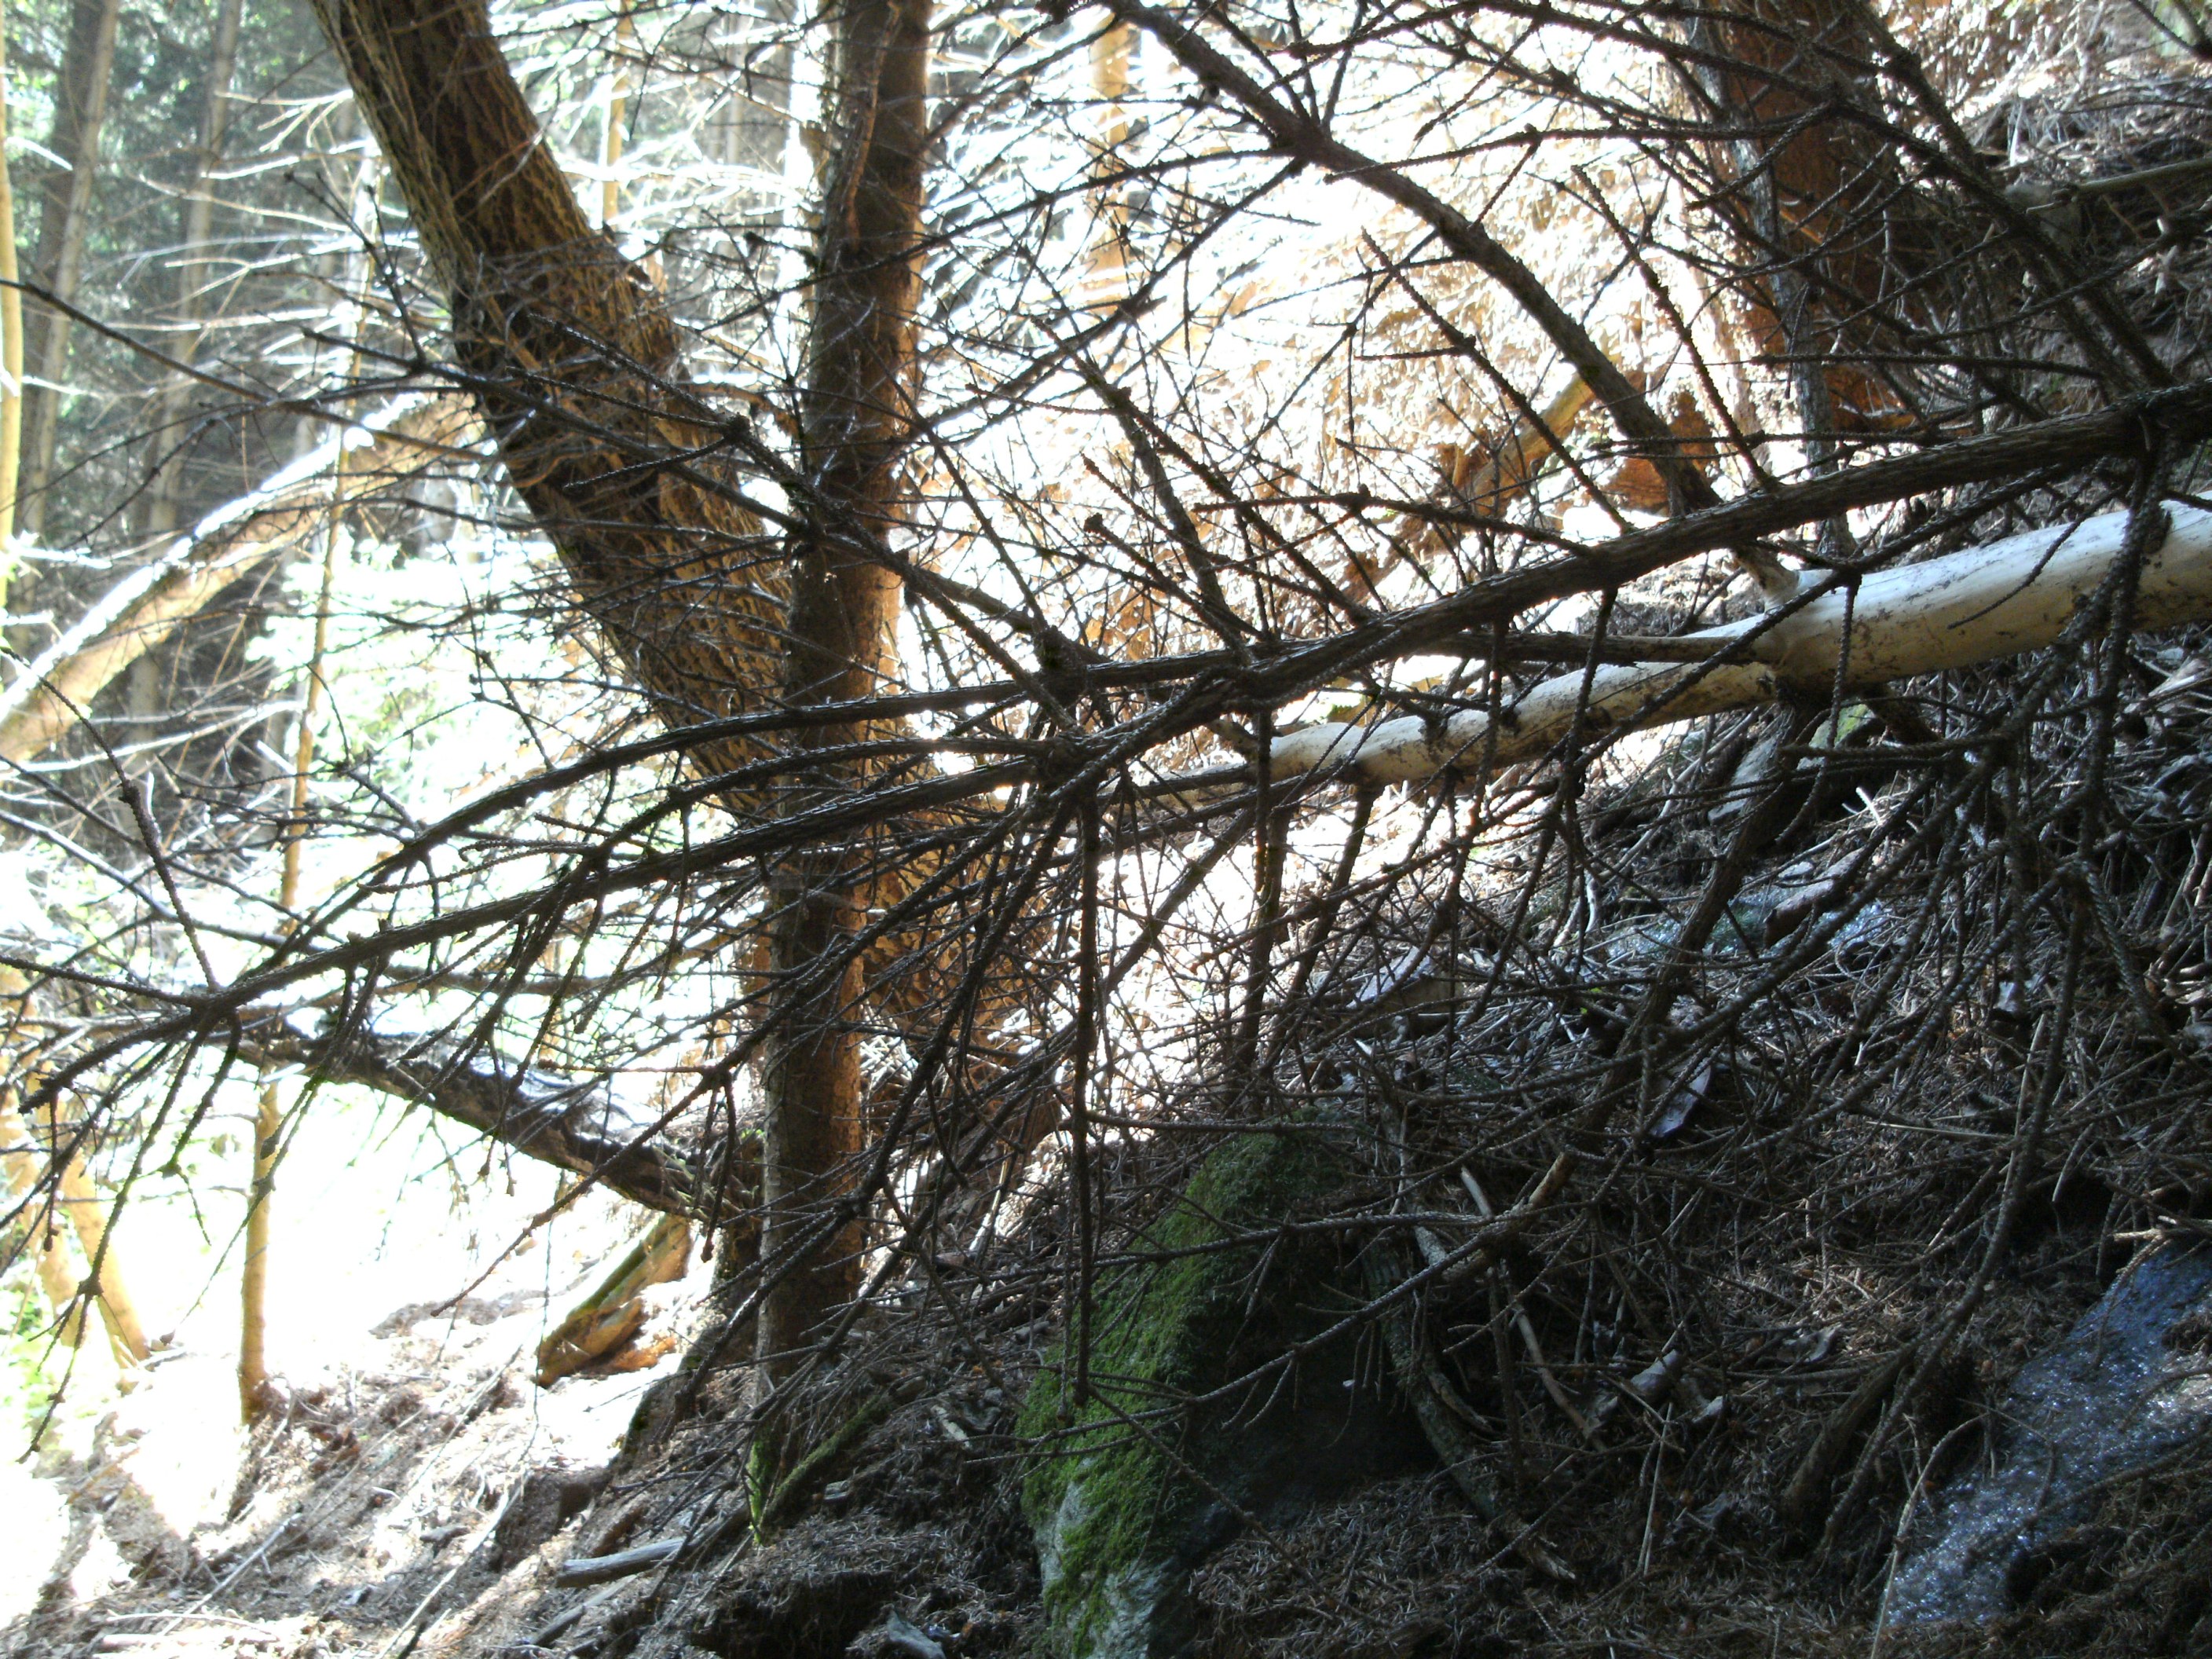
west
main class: Woodland
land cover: Spruce dominated coniferous woodland
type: alpine coniferous forest
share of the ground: > 75 %
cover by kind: coniferous forest trees 85 %, lichens and mosses 5 %, unconsolidated bare surface 5 %
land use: Forestry
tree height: > 5 m
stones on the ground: 10 - 25 %
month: July
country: AT
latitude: 46.7785
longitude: 14.9360
